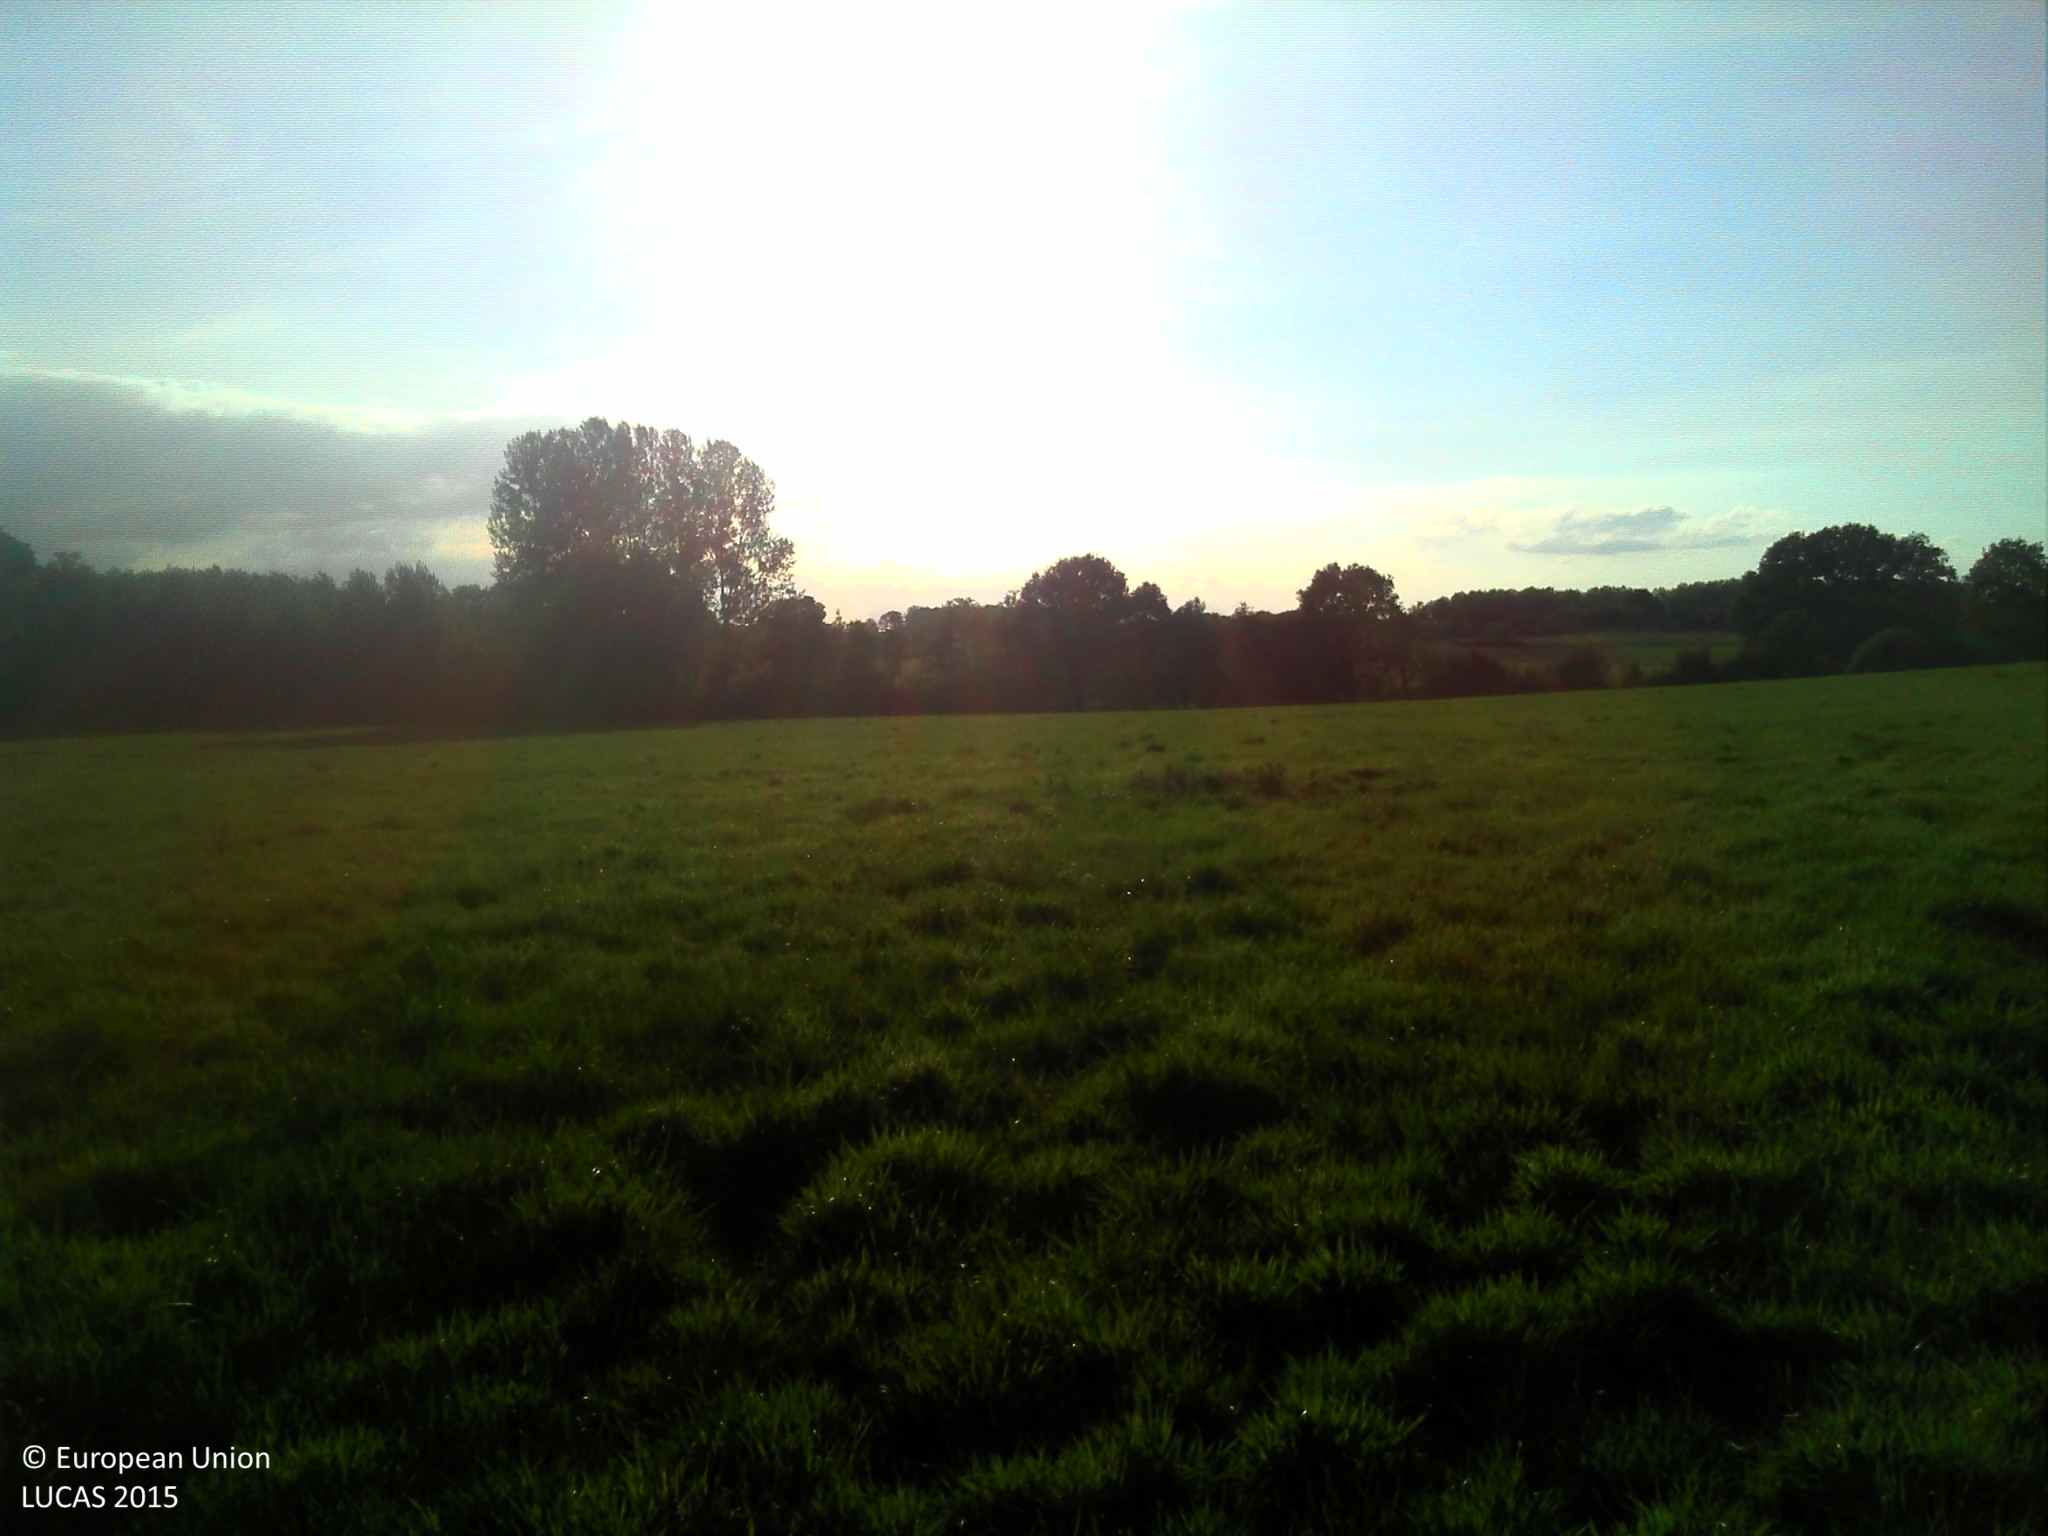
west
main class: Grassland
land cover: Grassland without tree/shrub cover
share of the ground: > 75 %
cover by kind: herbaceous plants 100 %
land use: Agriculture (excluding fallow land and kitchen gardens)
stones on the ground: < 10 %
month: September
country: FR
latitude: 48.4107
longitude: 0.5049
